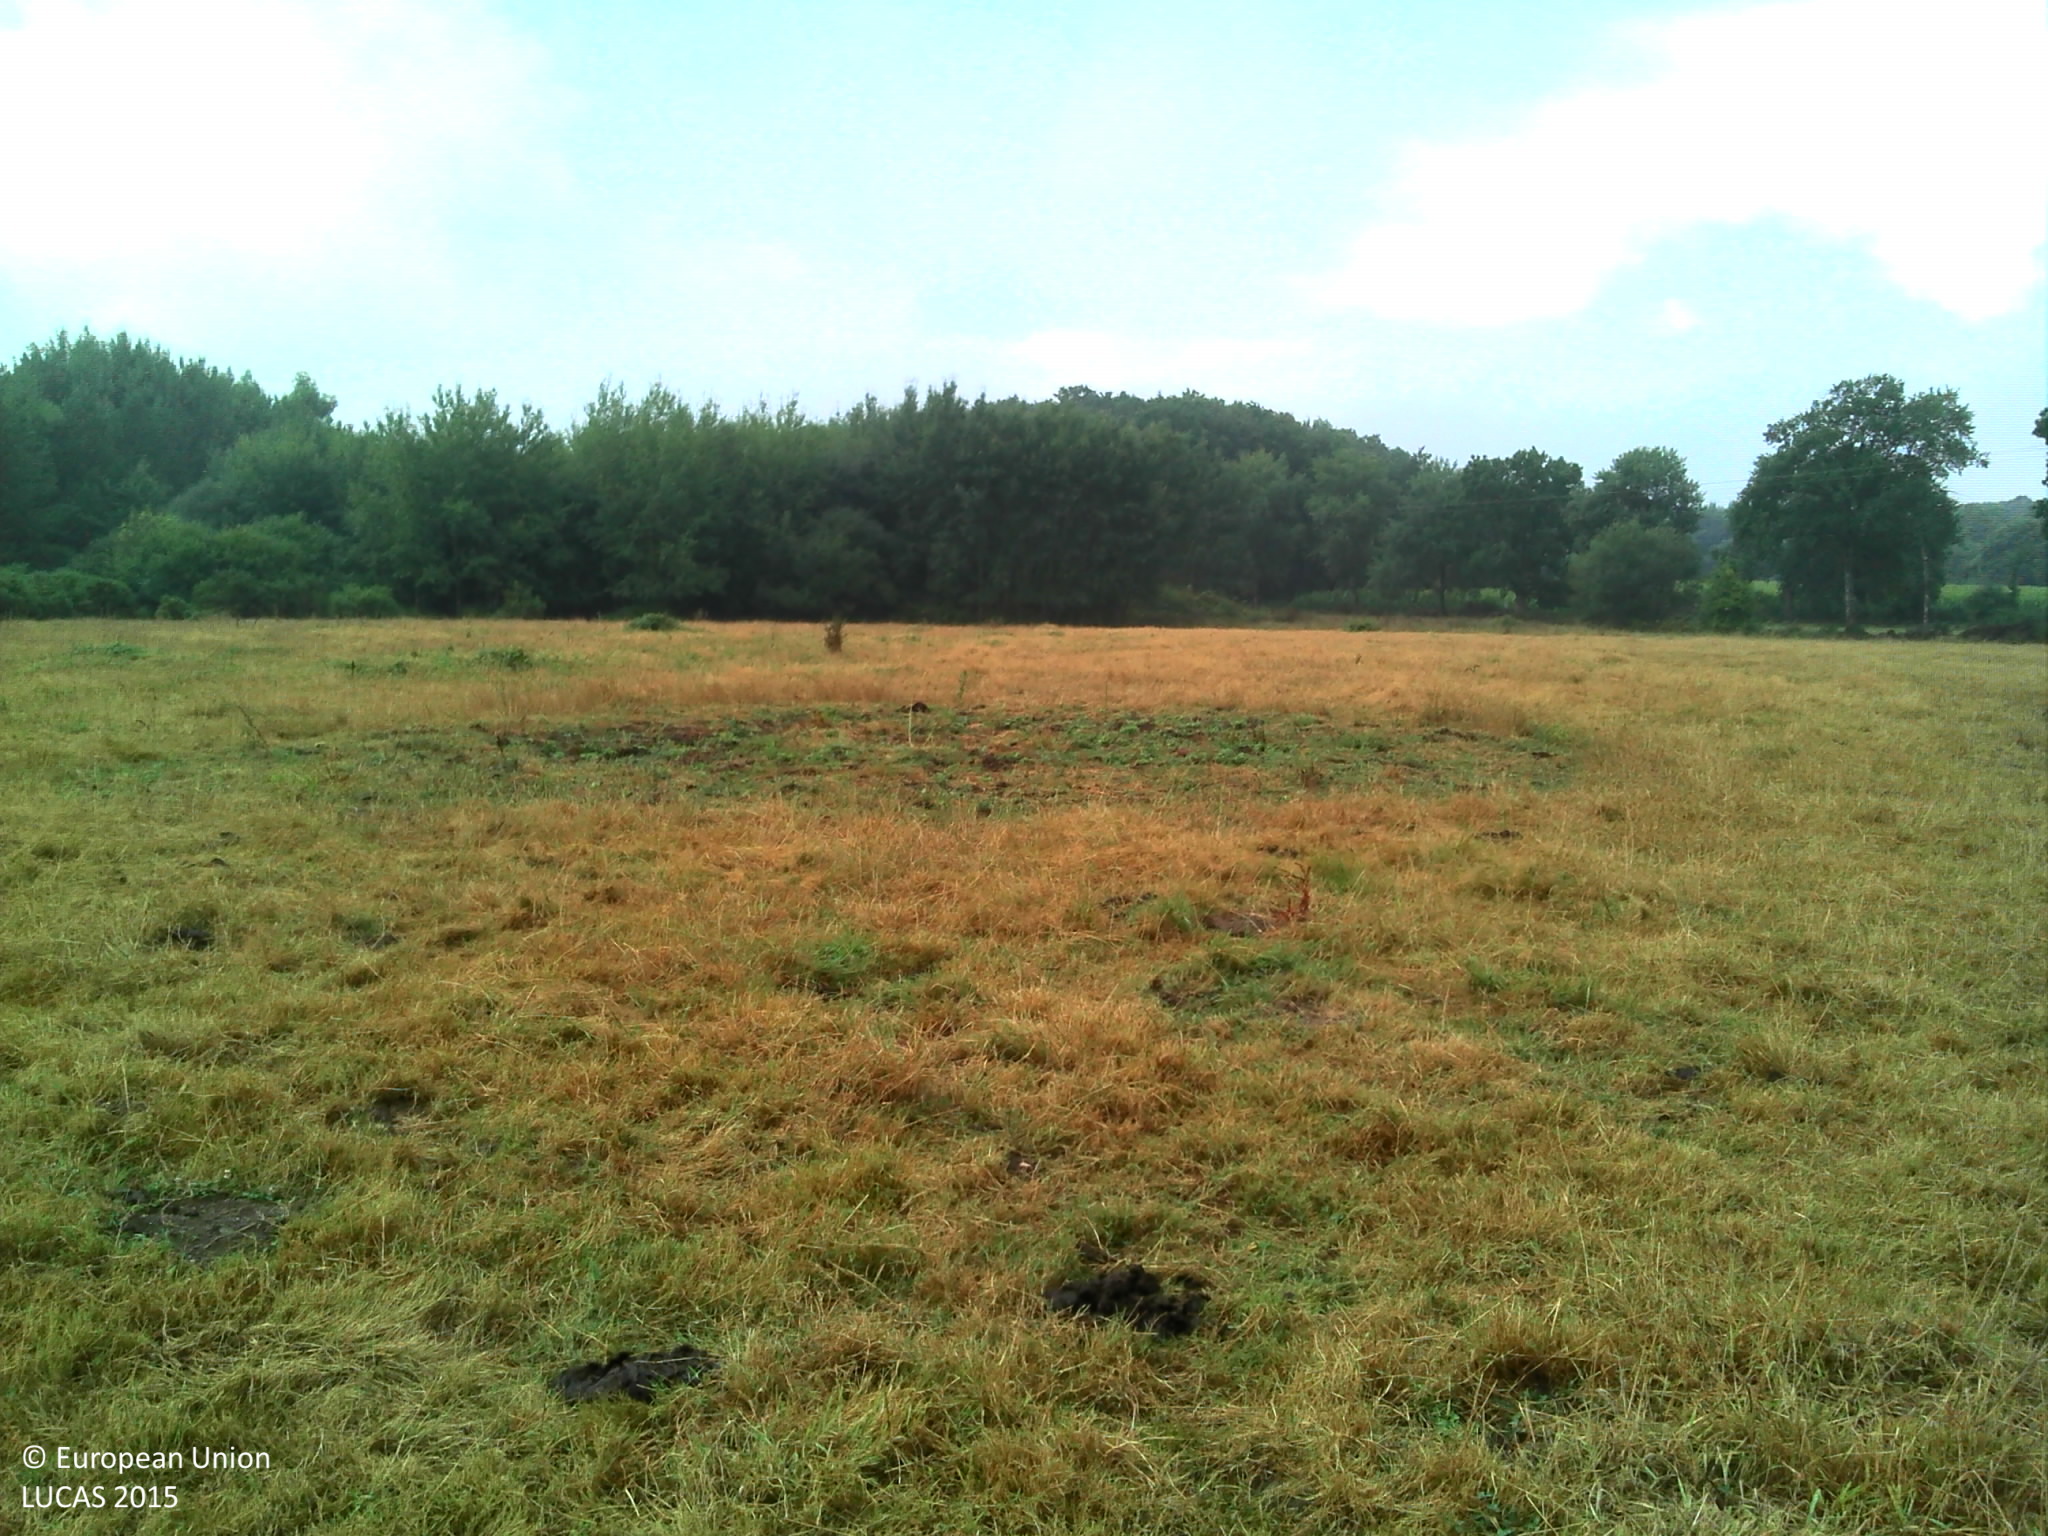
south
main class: Grassland
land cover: Grassland without tree/shrub cover
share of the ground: > 75 %
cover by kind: herbaceous plants 100 %
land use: Agriculture (excluding fallow land and kitchen gardens)
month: August
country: FR
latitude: 46.9142
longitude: -1.6356
